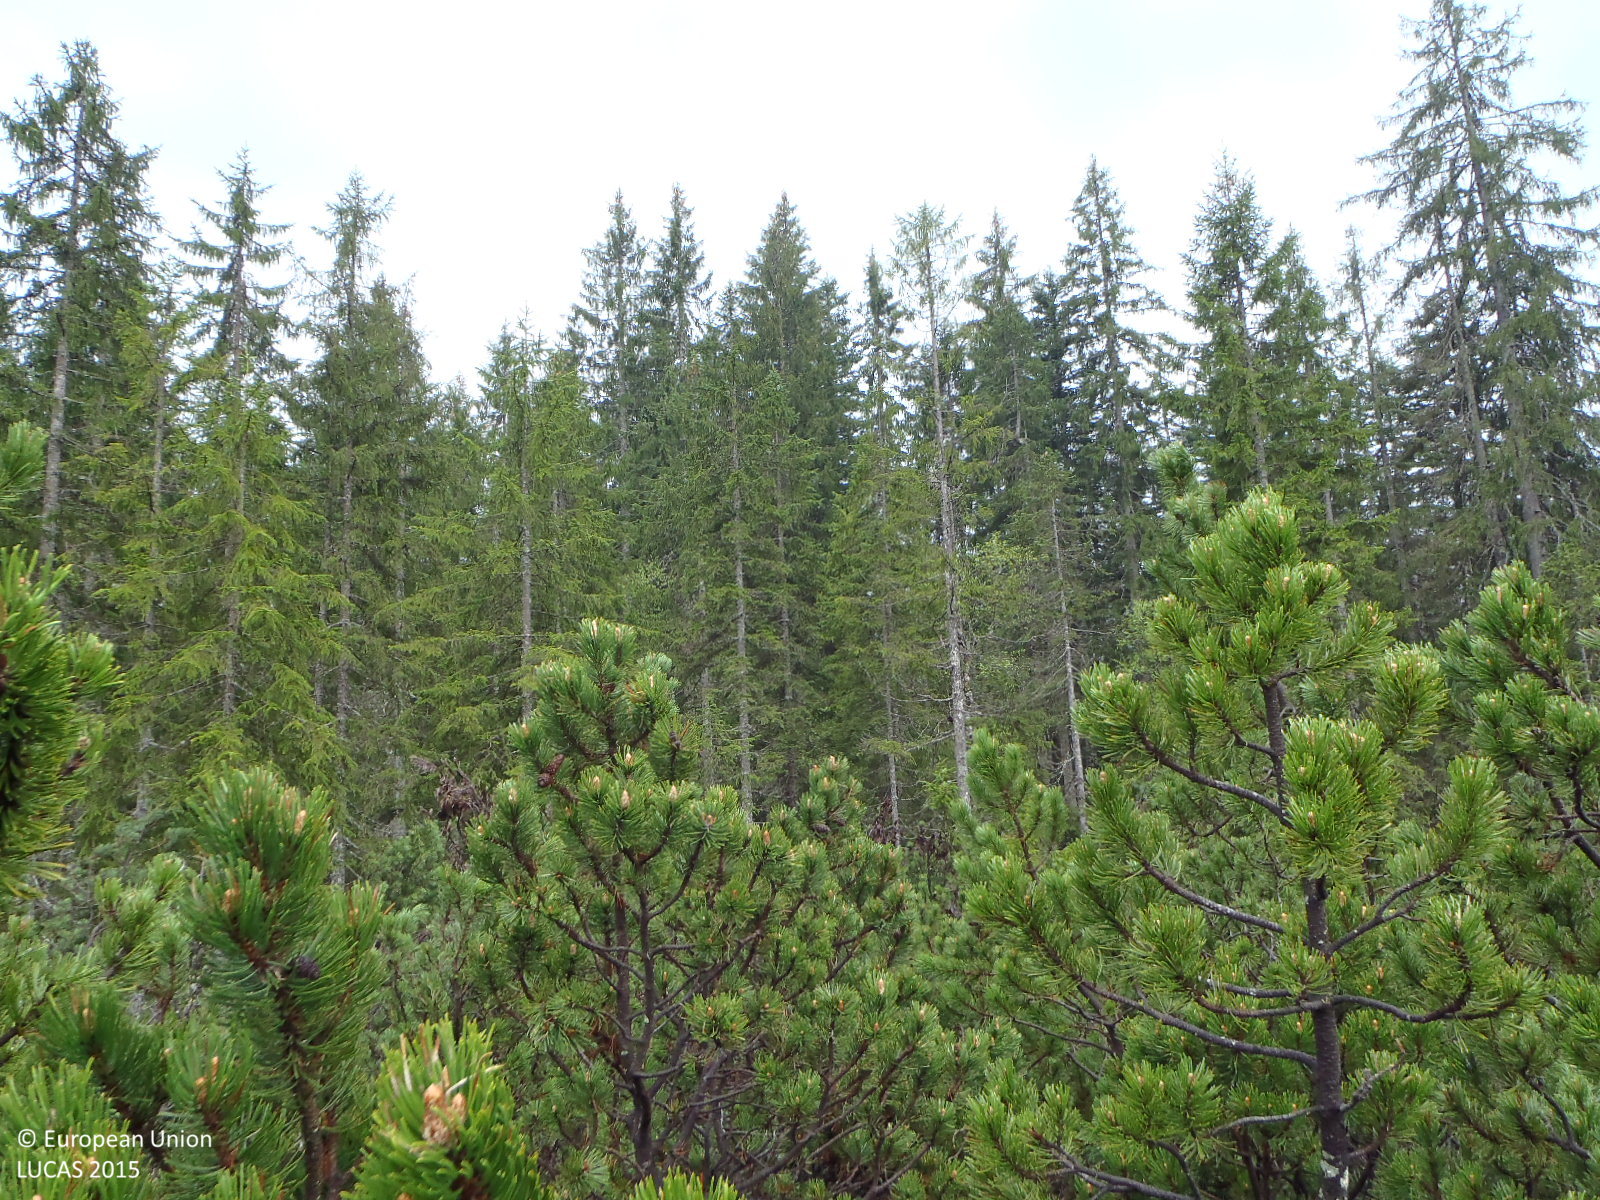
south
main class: Woodland
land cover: Pine dominated coniferous woodland
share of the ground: > 75 %
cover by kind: coniferous forest trees 80 %, herbaceous plants 10 %, shrubs 5 %, lichens and mosses 5 %
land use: Forestry
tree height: < 5 m
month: May
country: AT
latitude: 47.6528
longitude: 12.5946
